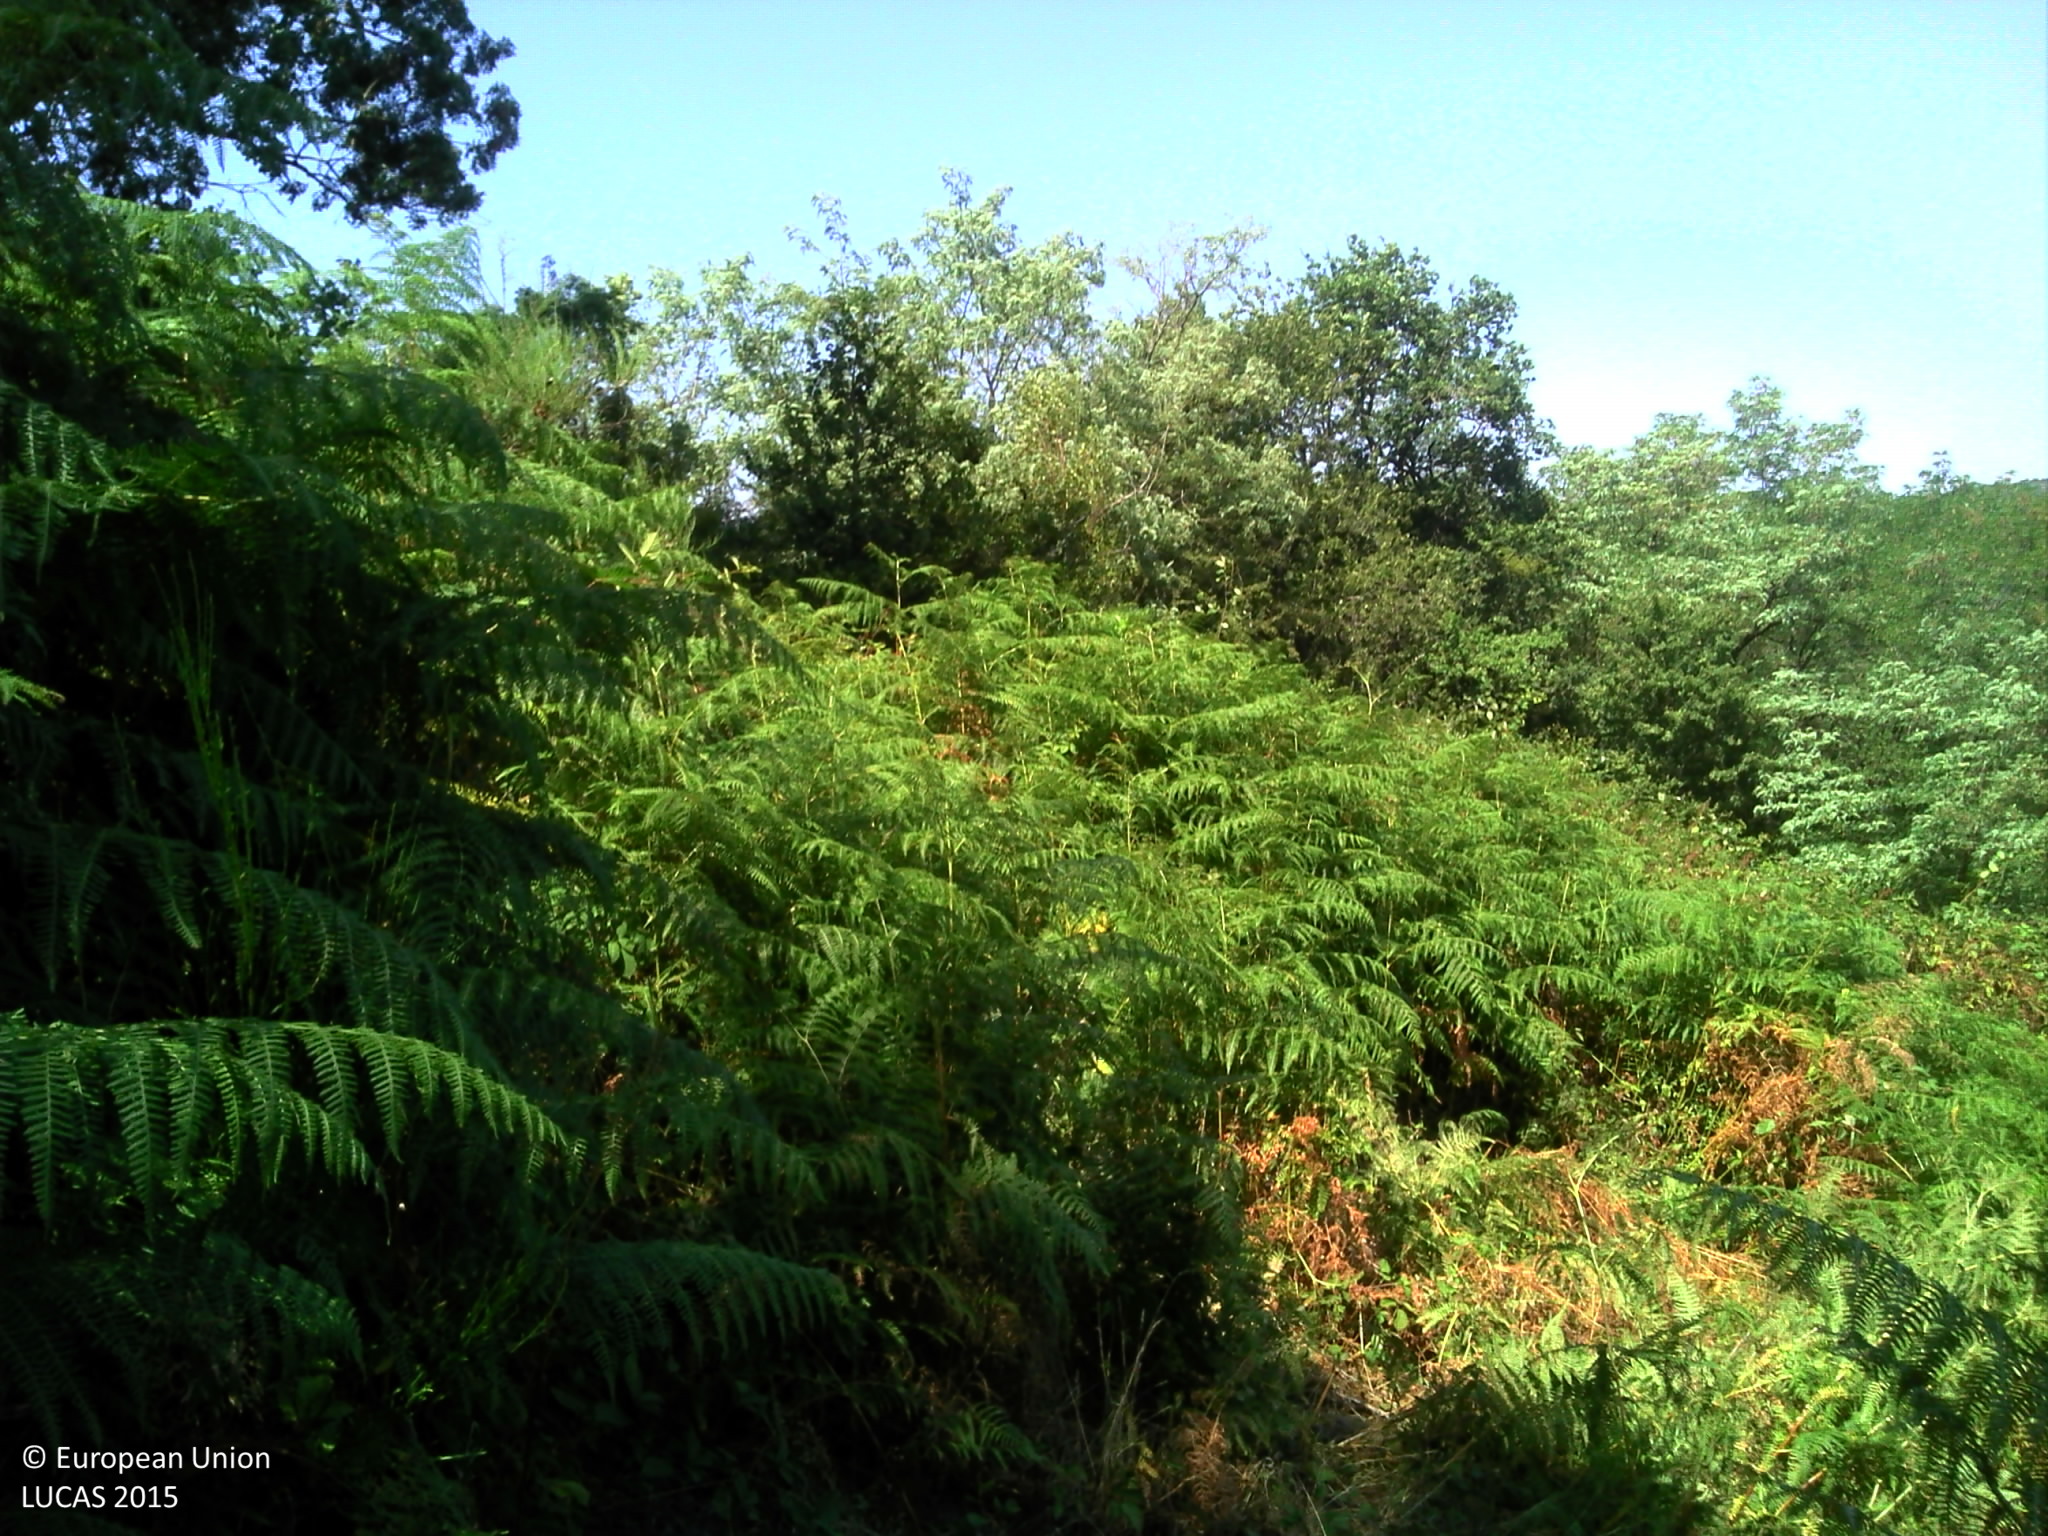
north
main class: Grassland
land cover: Spontaneously vegetated surfaces
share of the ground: > 75 %
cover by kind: herbaceous plants 95 %, shrubs 5 %
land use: Semi-natural and natural areas not in use
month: August
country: FR
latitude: 46.8198
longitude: 4.4299
